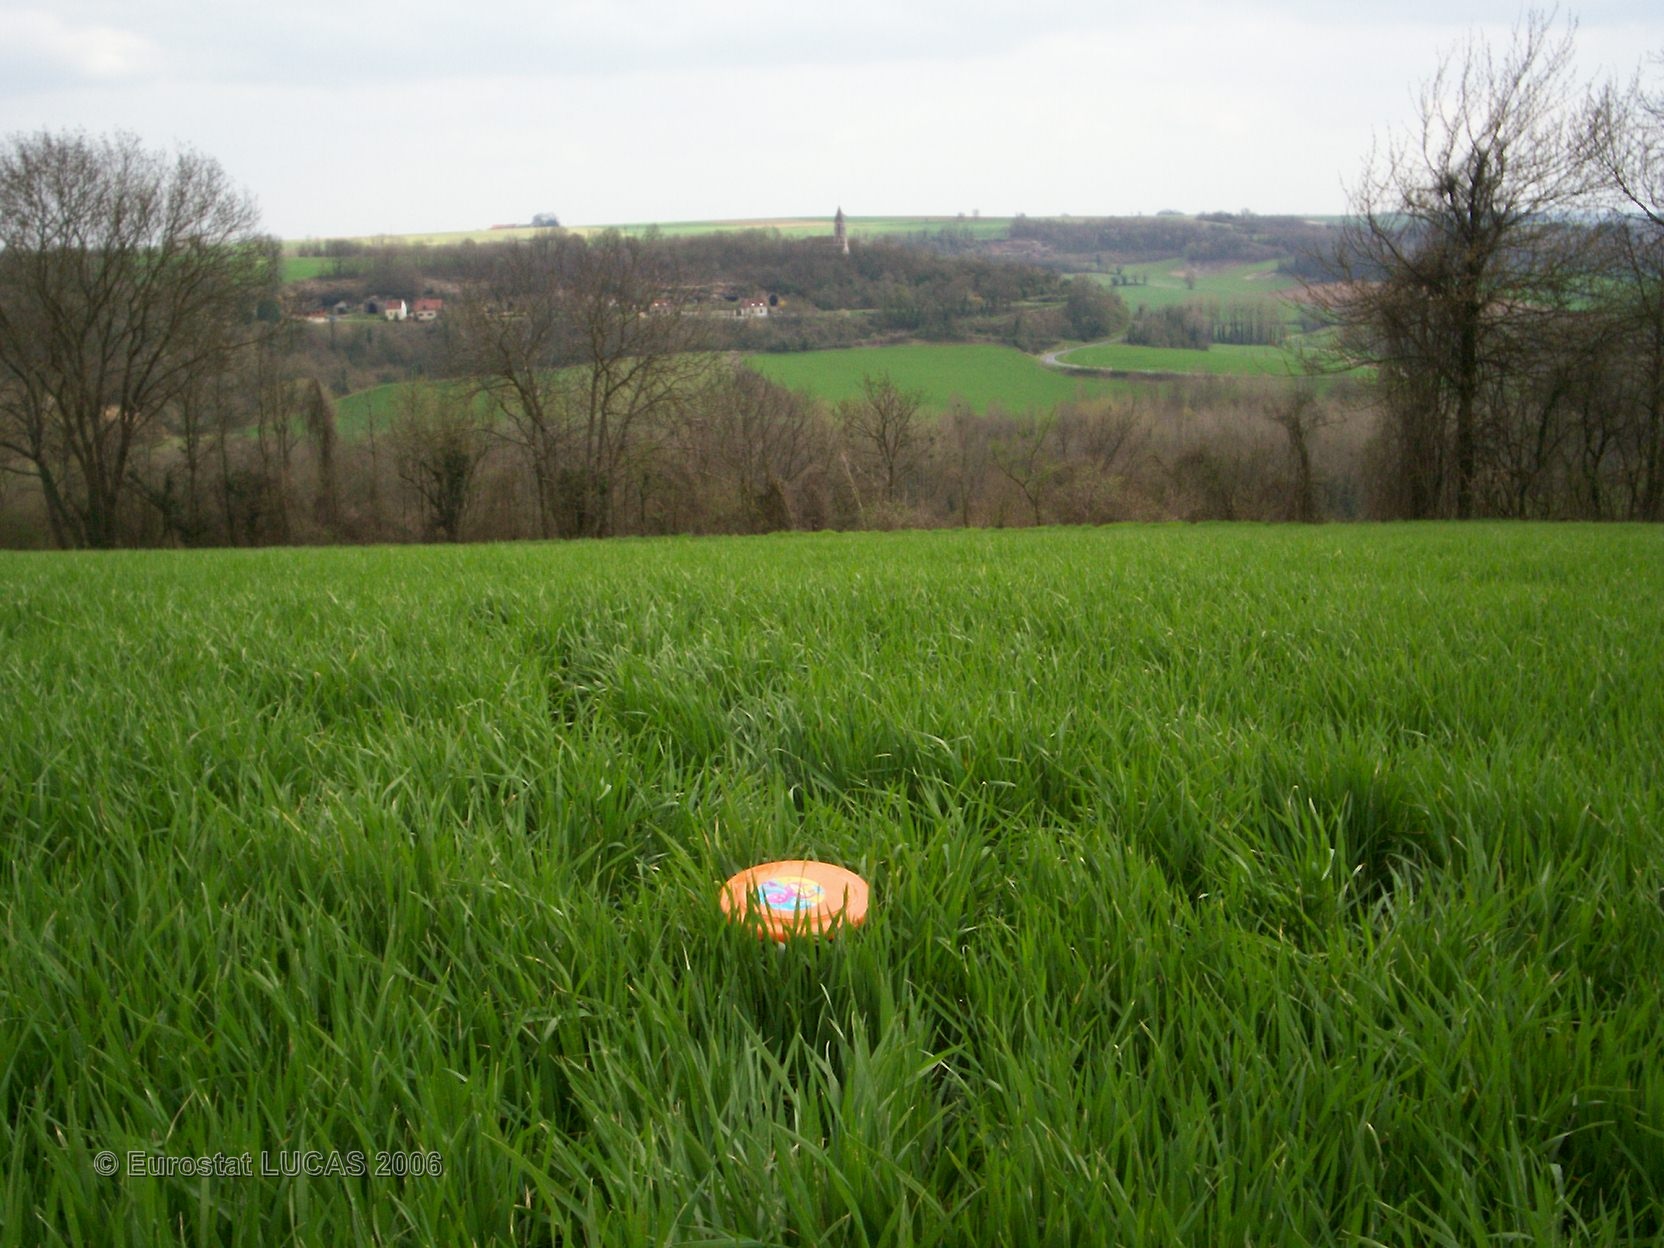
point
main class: Cropland
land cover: Common wheat
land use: Agriculture (excluding fallow land and kitchen gardens)
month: April
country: FR
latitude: 49.4323
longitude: 3.6921
